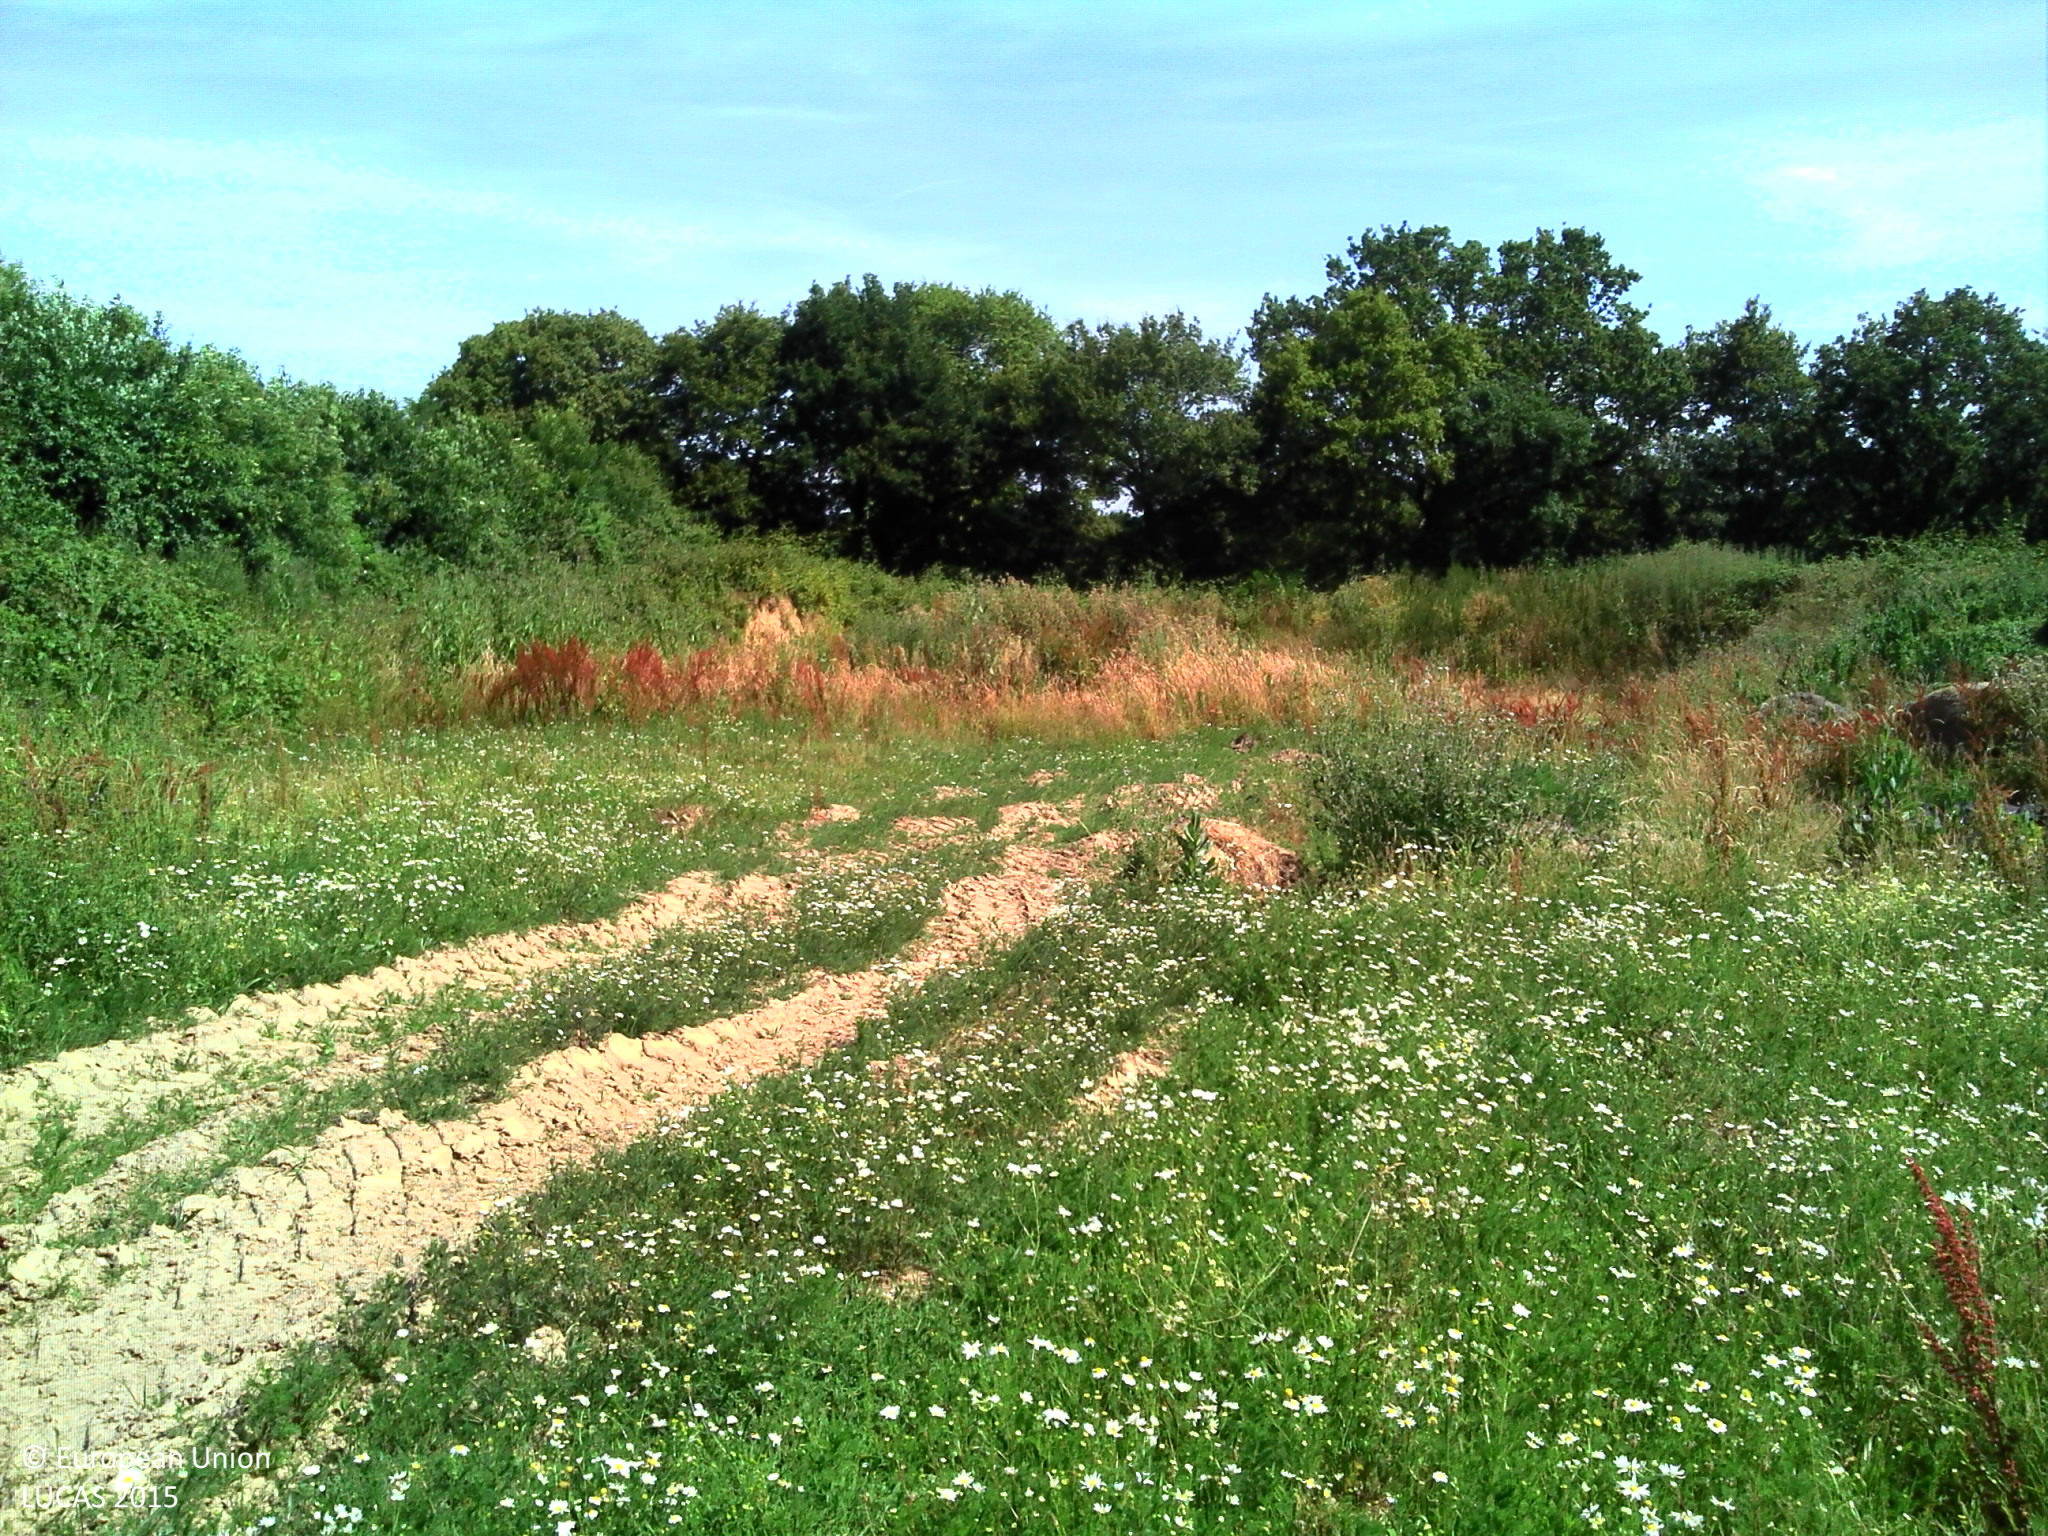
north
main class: Grassland
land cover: Spontaneously vegetated surfaces
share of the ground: > 75 %
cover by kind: herbaceous plants 95 %, unconsolidated bare surface 5 %
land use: Semi-natural and natural areas not in use
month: June
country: FR
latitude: 47.1962
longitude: -2.0470
